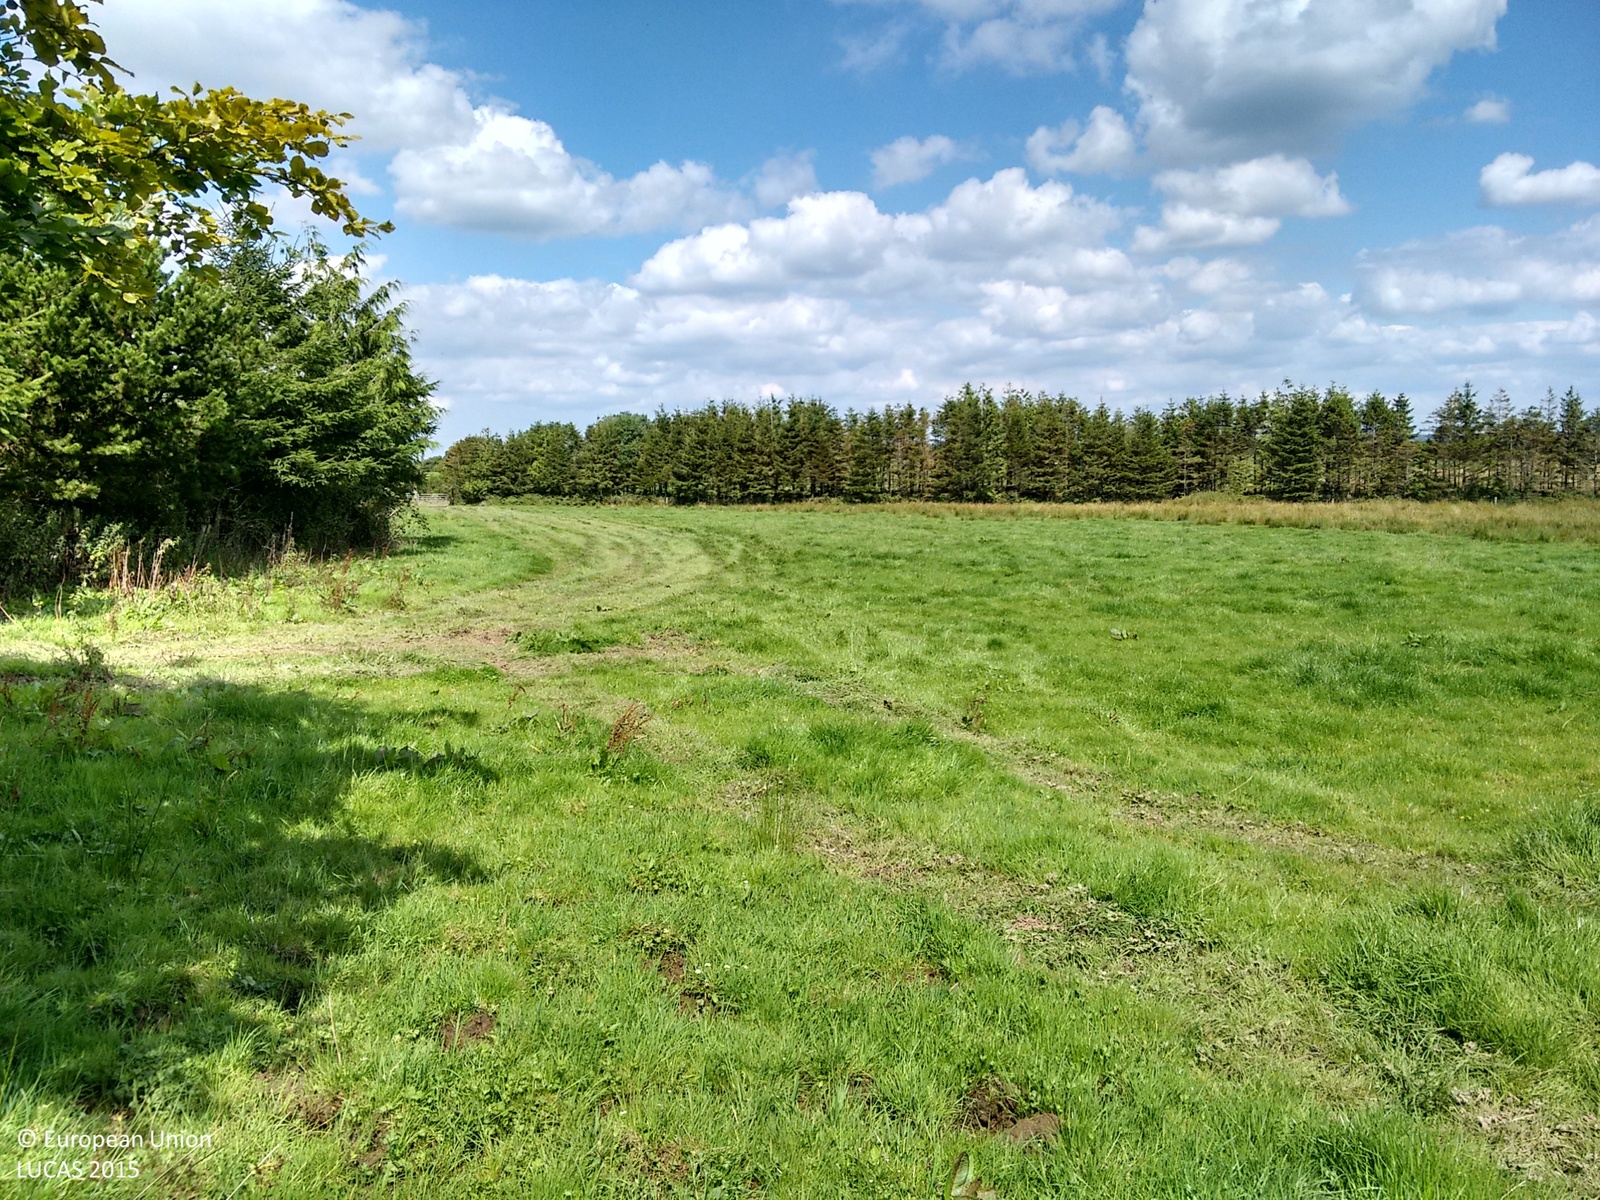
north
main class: Grassland
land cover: Grassland without tree/shrub cover
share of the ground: > 75 %
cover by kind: herbaceous plants 100 %
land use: Agriculture (excluding fallow land and kitchen gardens)
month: August
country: GB
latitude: 51.8229
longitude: -4.3940
